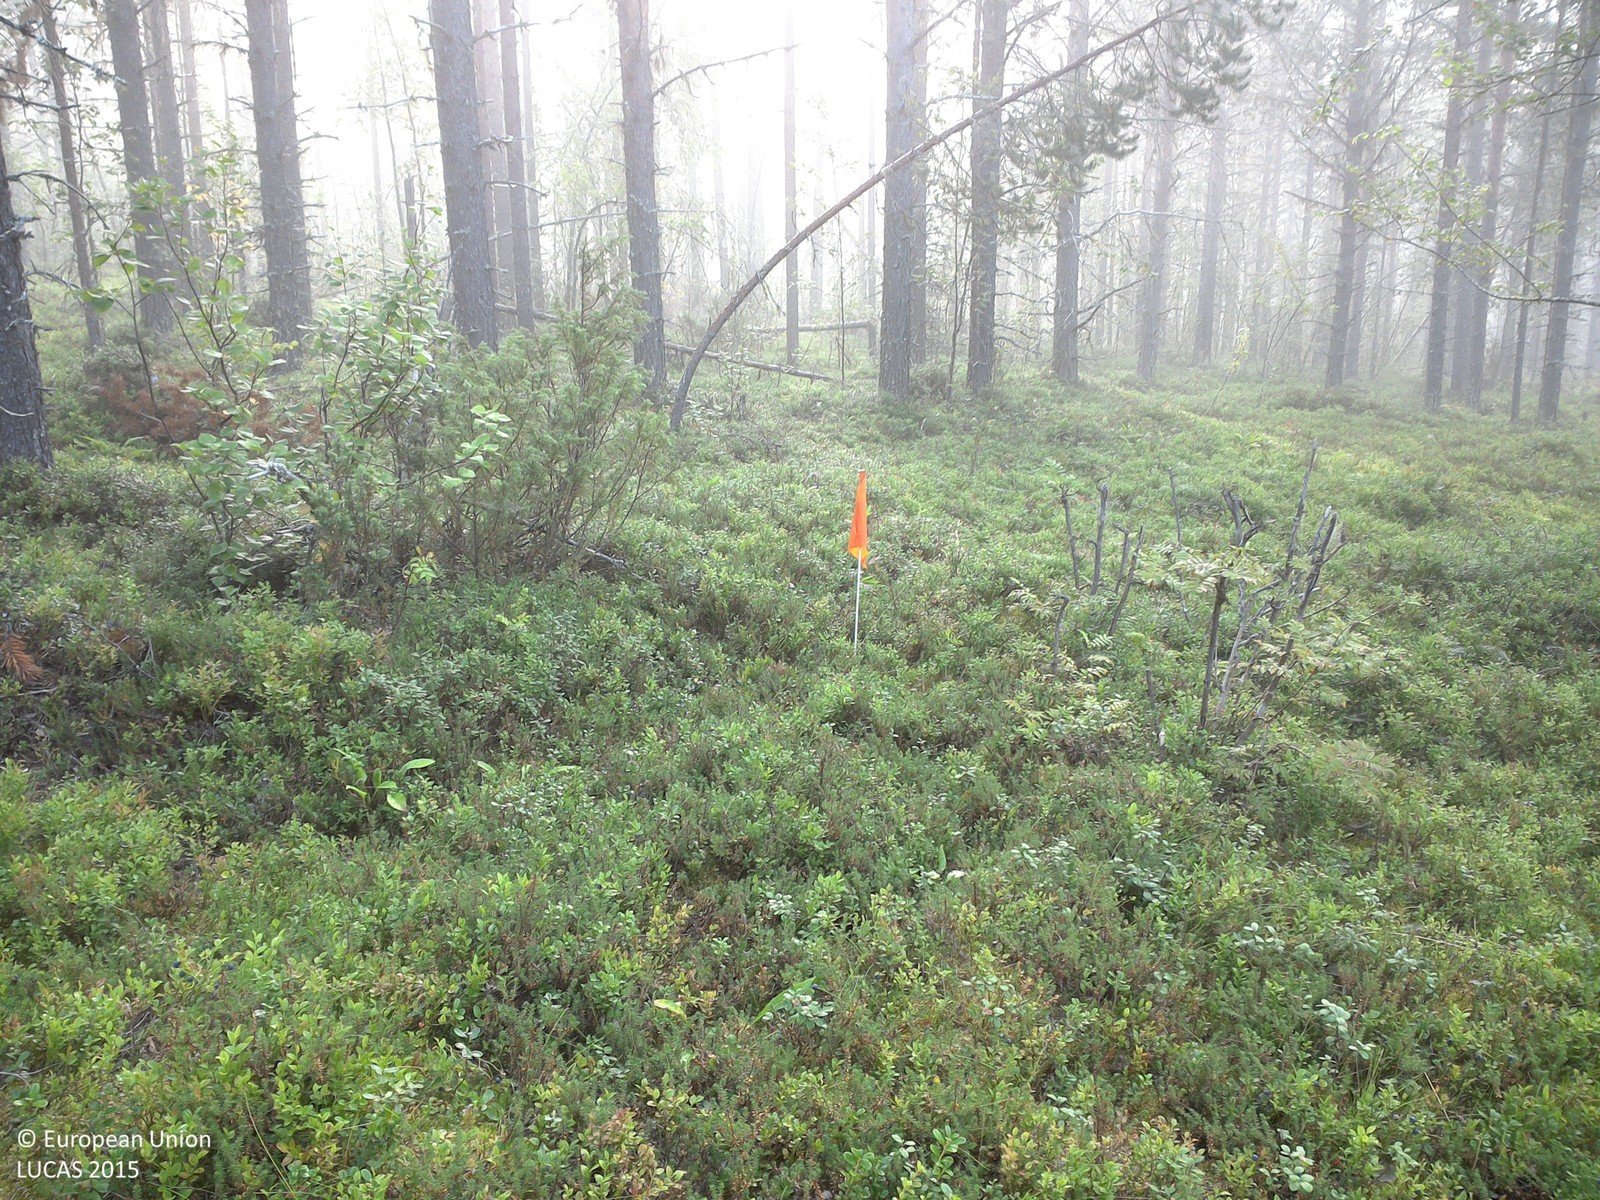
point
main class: Woodland
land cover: Pine dominated coniferous woodland
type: boreal forest
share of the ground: 25 - 50 %
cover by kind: shrubs 60 %, coniferous forest trees 30 %, broadleaved forest trees 5 %, lichens and mosses 5 %
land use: Forestry
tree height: > 5 m
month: August
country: SE
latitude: 67.1224
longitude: 21.8746
